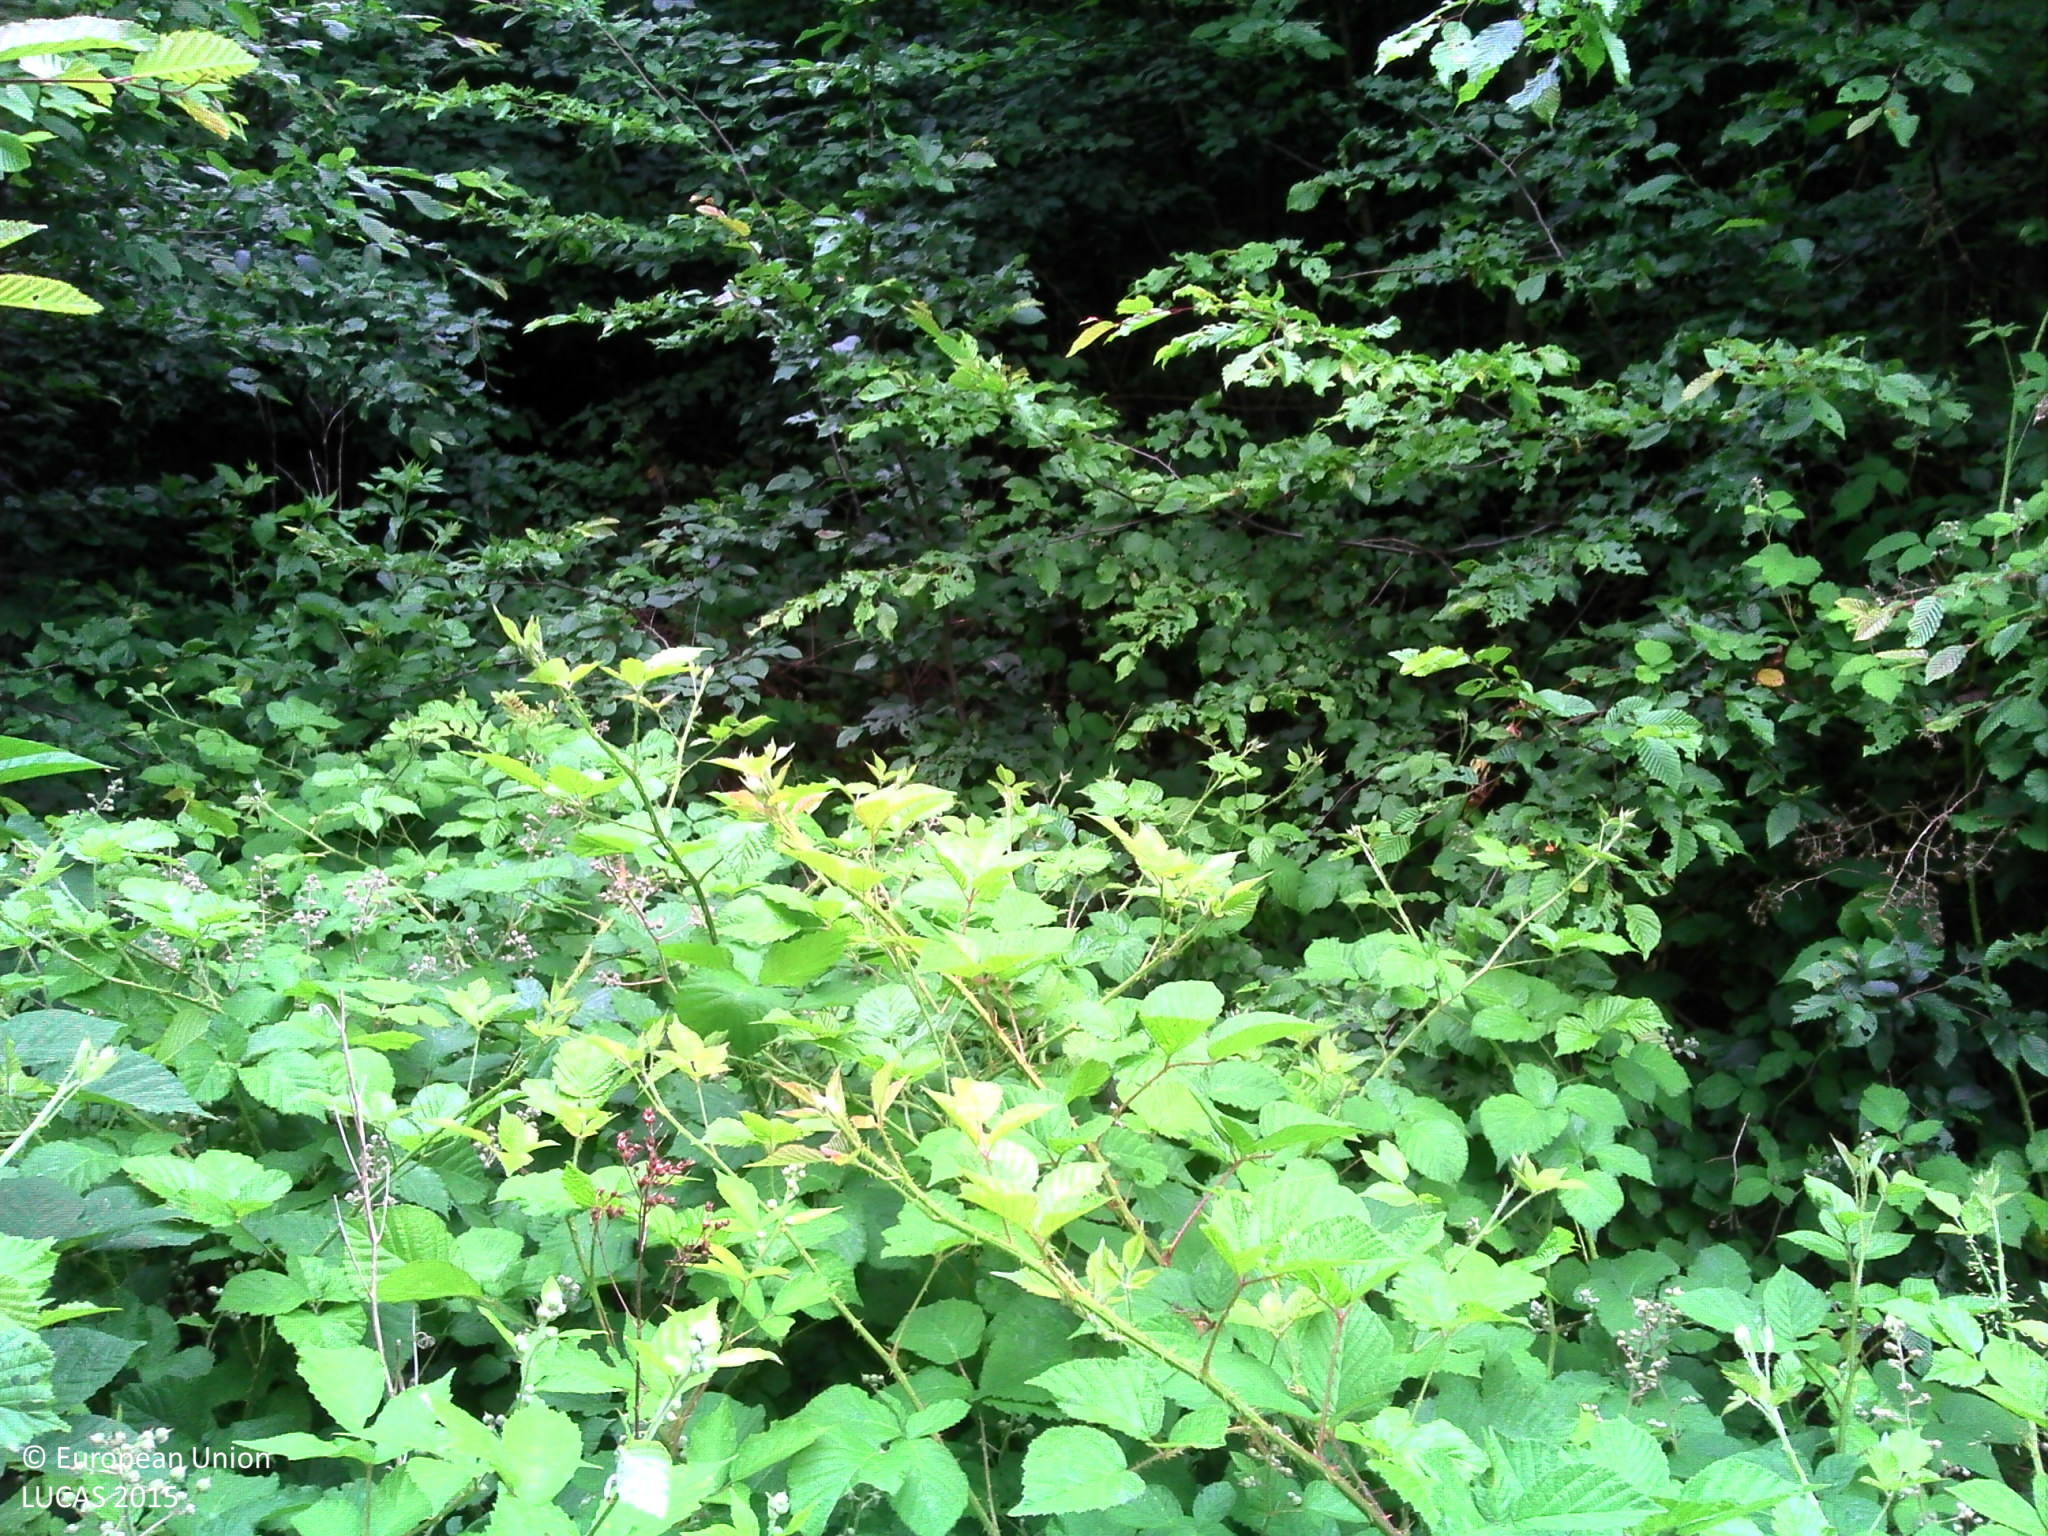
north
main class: Woodland
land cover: Broadleaved woodland
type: mesophytic deciduous forest
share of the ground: > 75 %
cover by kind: broadleaved forest trees 95 %, herbaceous plants 5 %
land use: Forestry
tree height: > 5 m
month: June
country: FR
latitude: 48.8623
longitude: 6.2514
